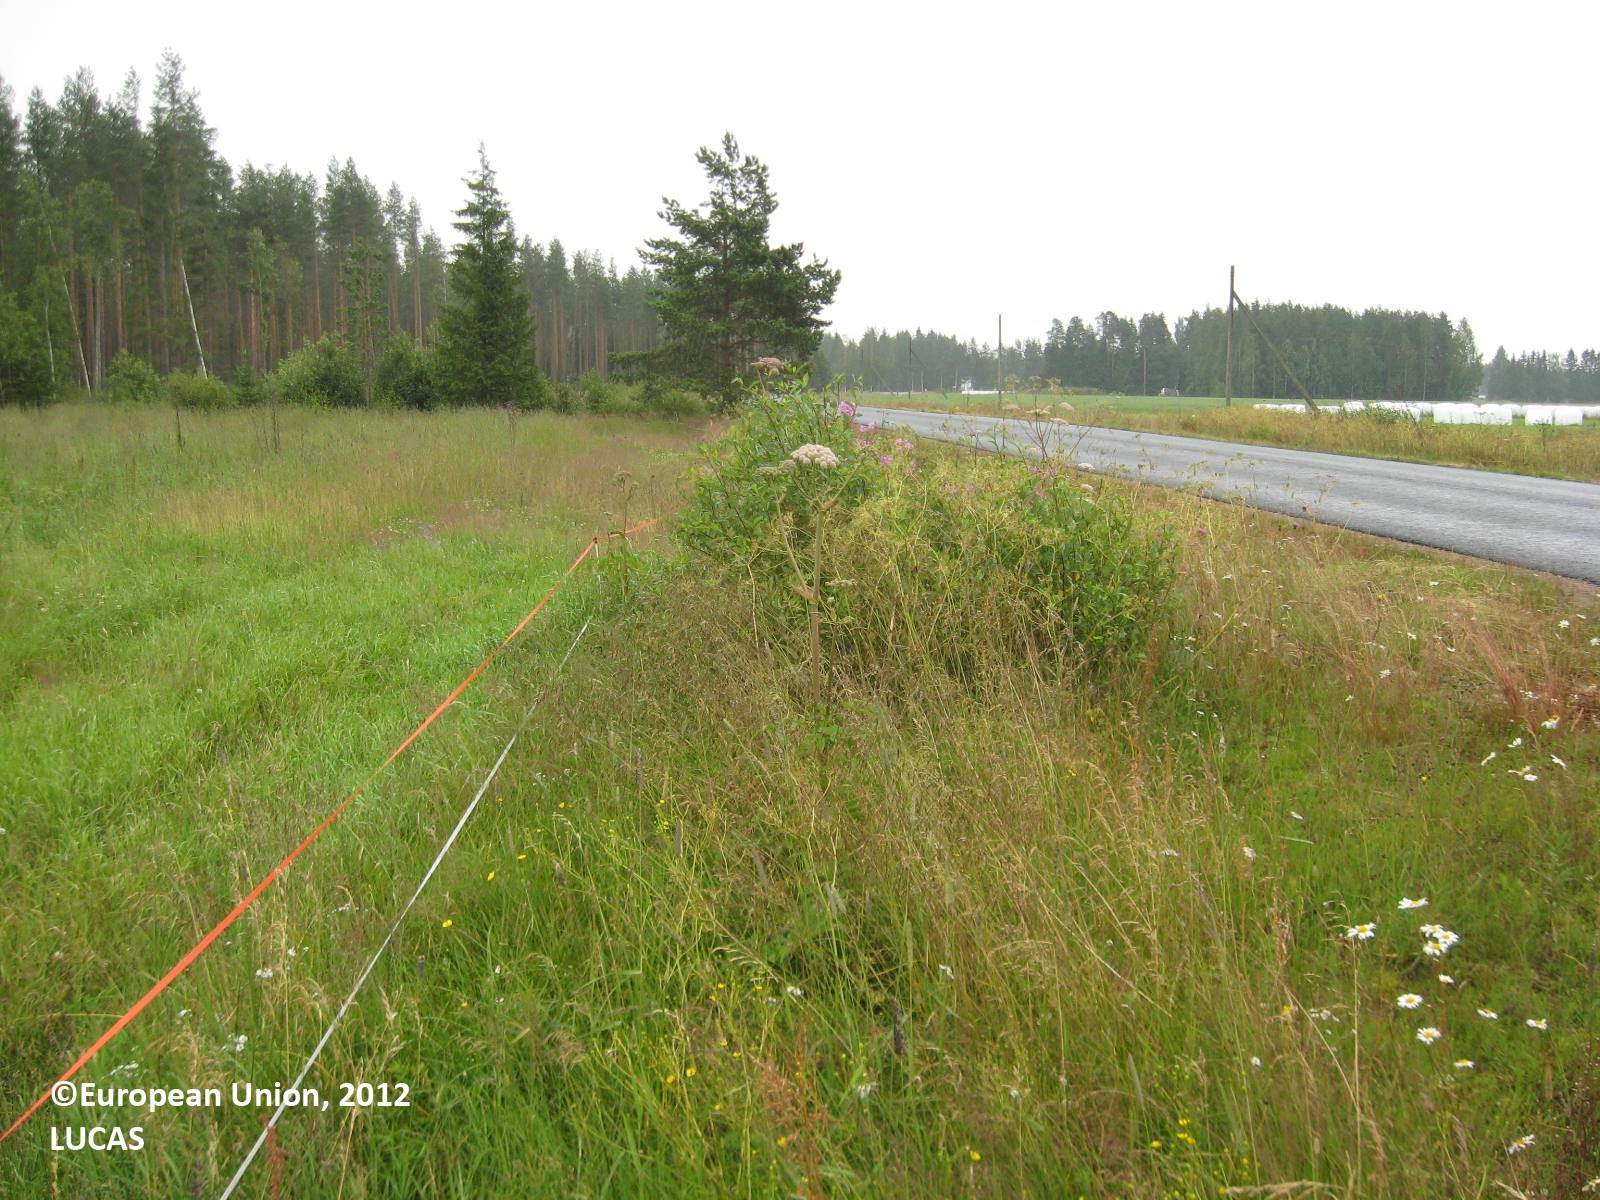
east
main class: Grassland
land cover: Grassland without tree/shrub cover
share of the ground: > 75 %
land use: Agriculture (excluding fallow land and kitchen gardens)
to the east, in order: Grassland without tree/shrub cover; Fences; Shruby margins; Ditches and canals; Broadleaved woodland
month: July
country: FI
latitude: 62.1834
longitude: 22.6814
